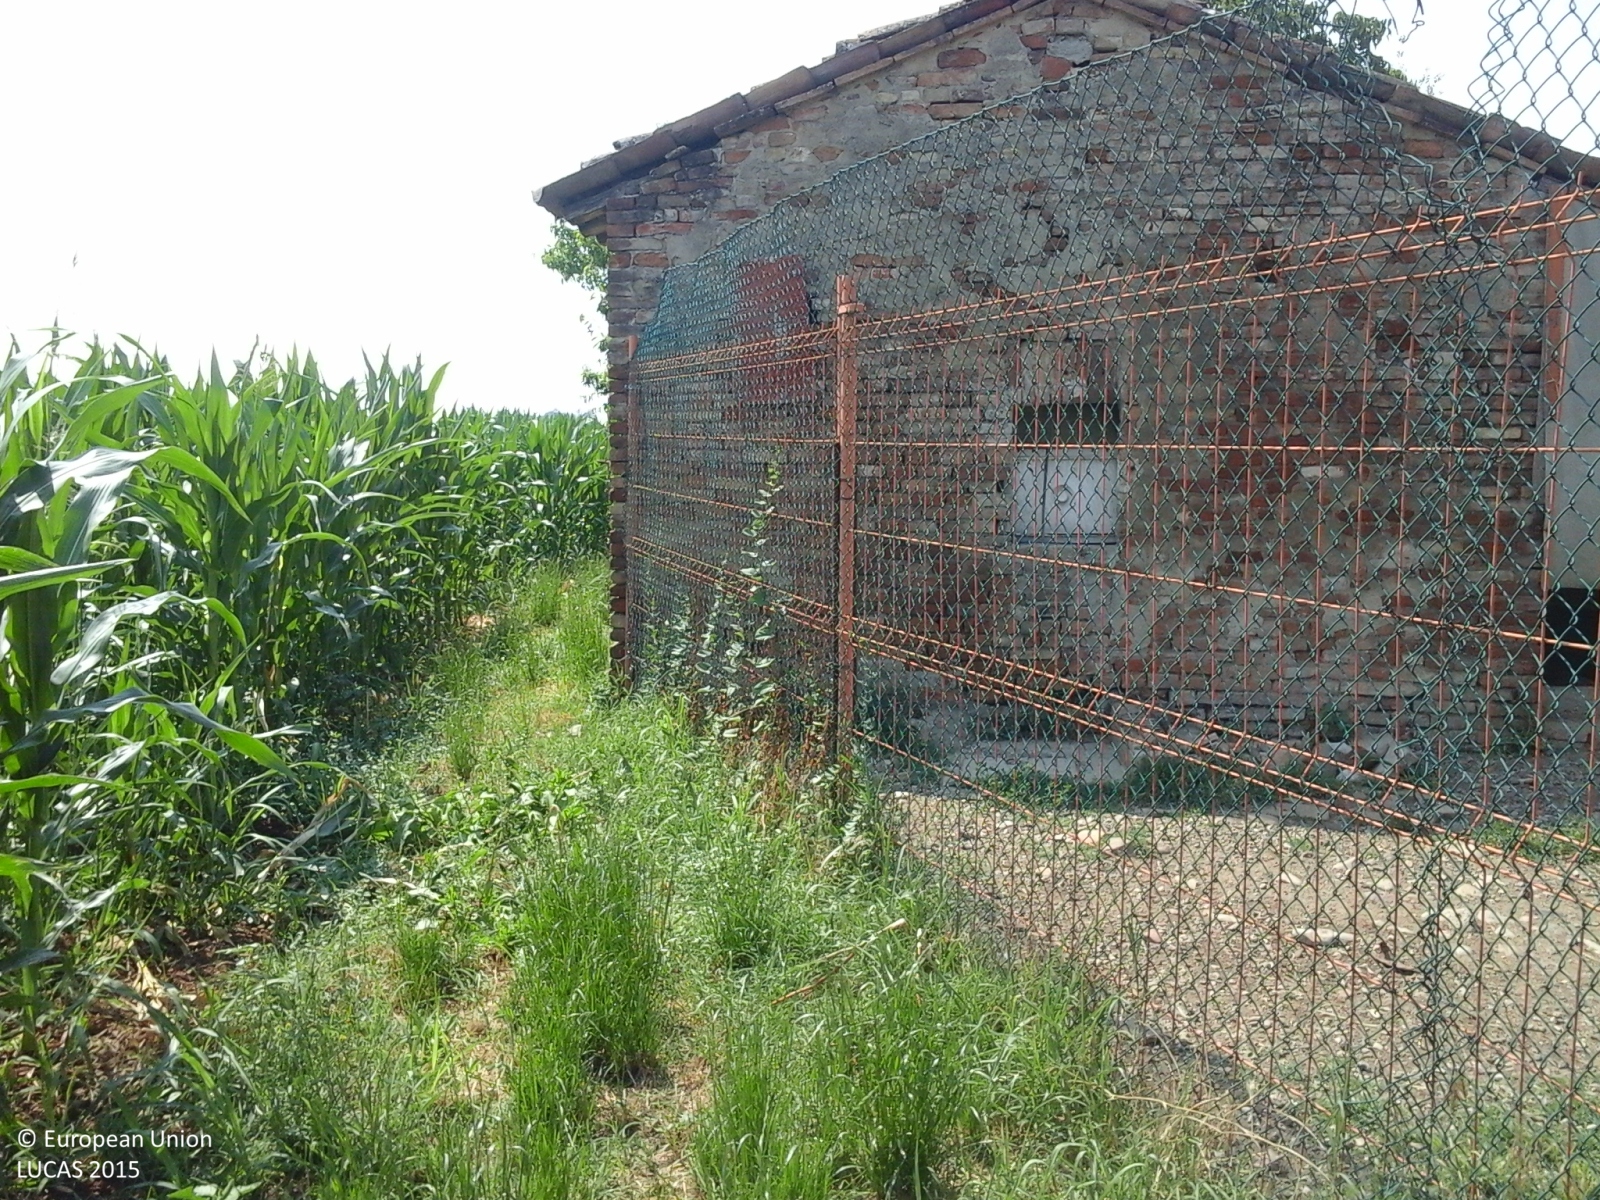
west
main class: Cropland
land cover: Maize
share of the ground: > 75 %
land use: Agriculture (excluding fallow land and kitchen gardens)
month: June
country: IT
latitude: 44.9095
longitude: 9.9115
